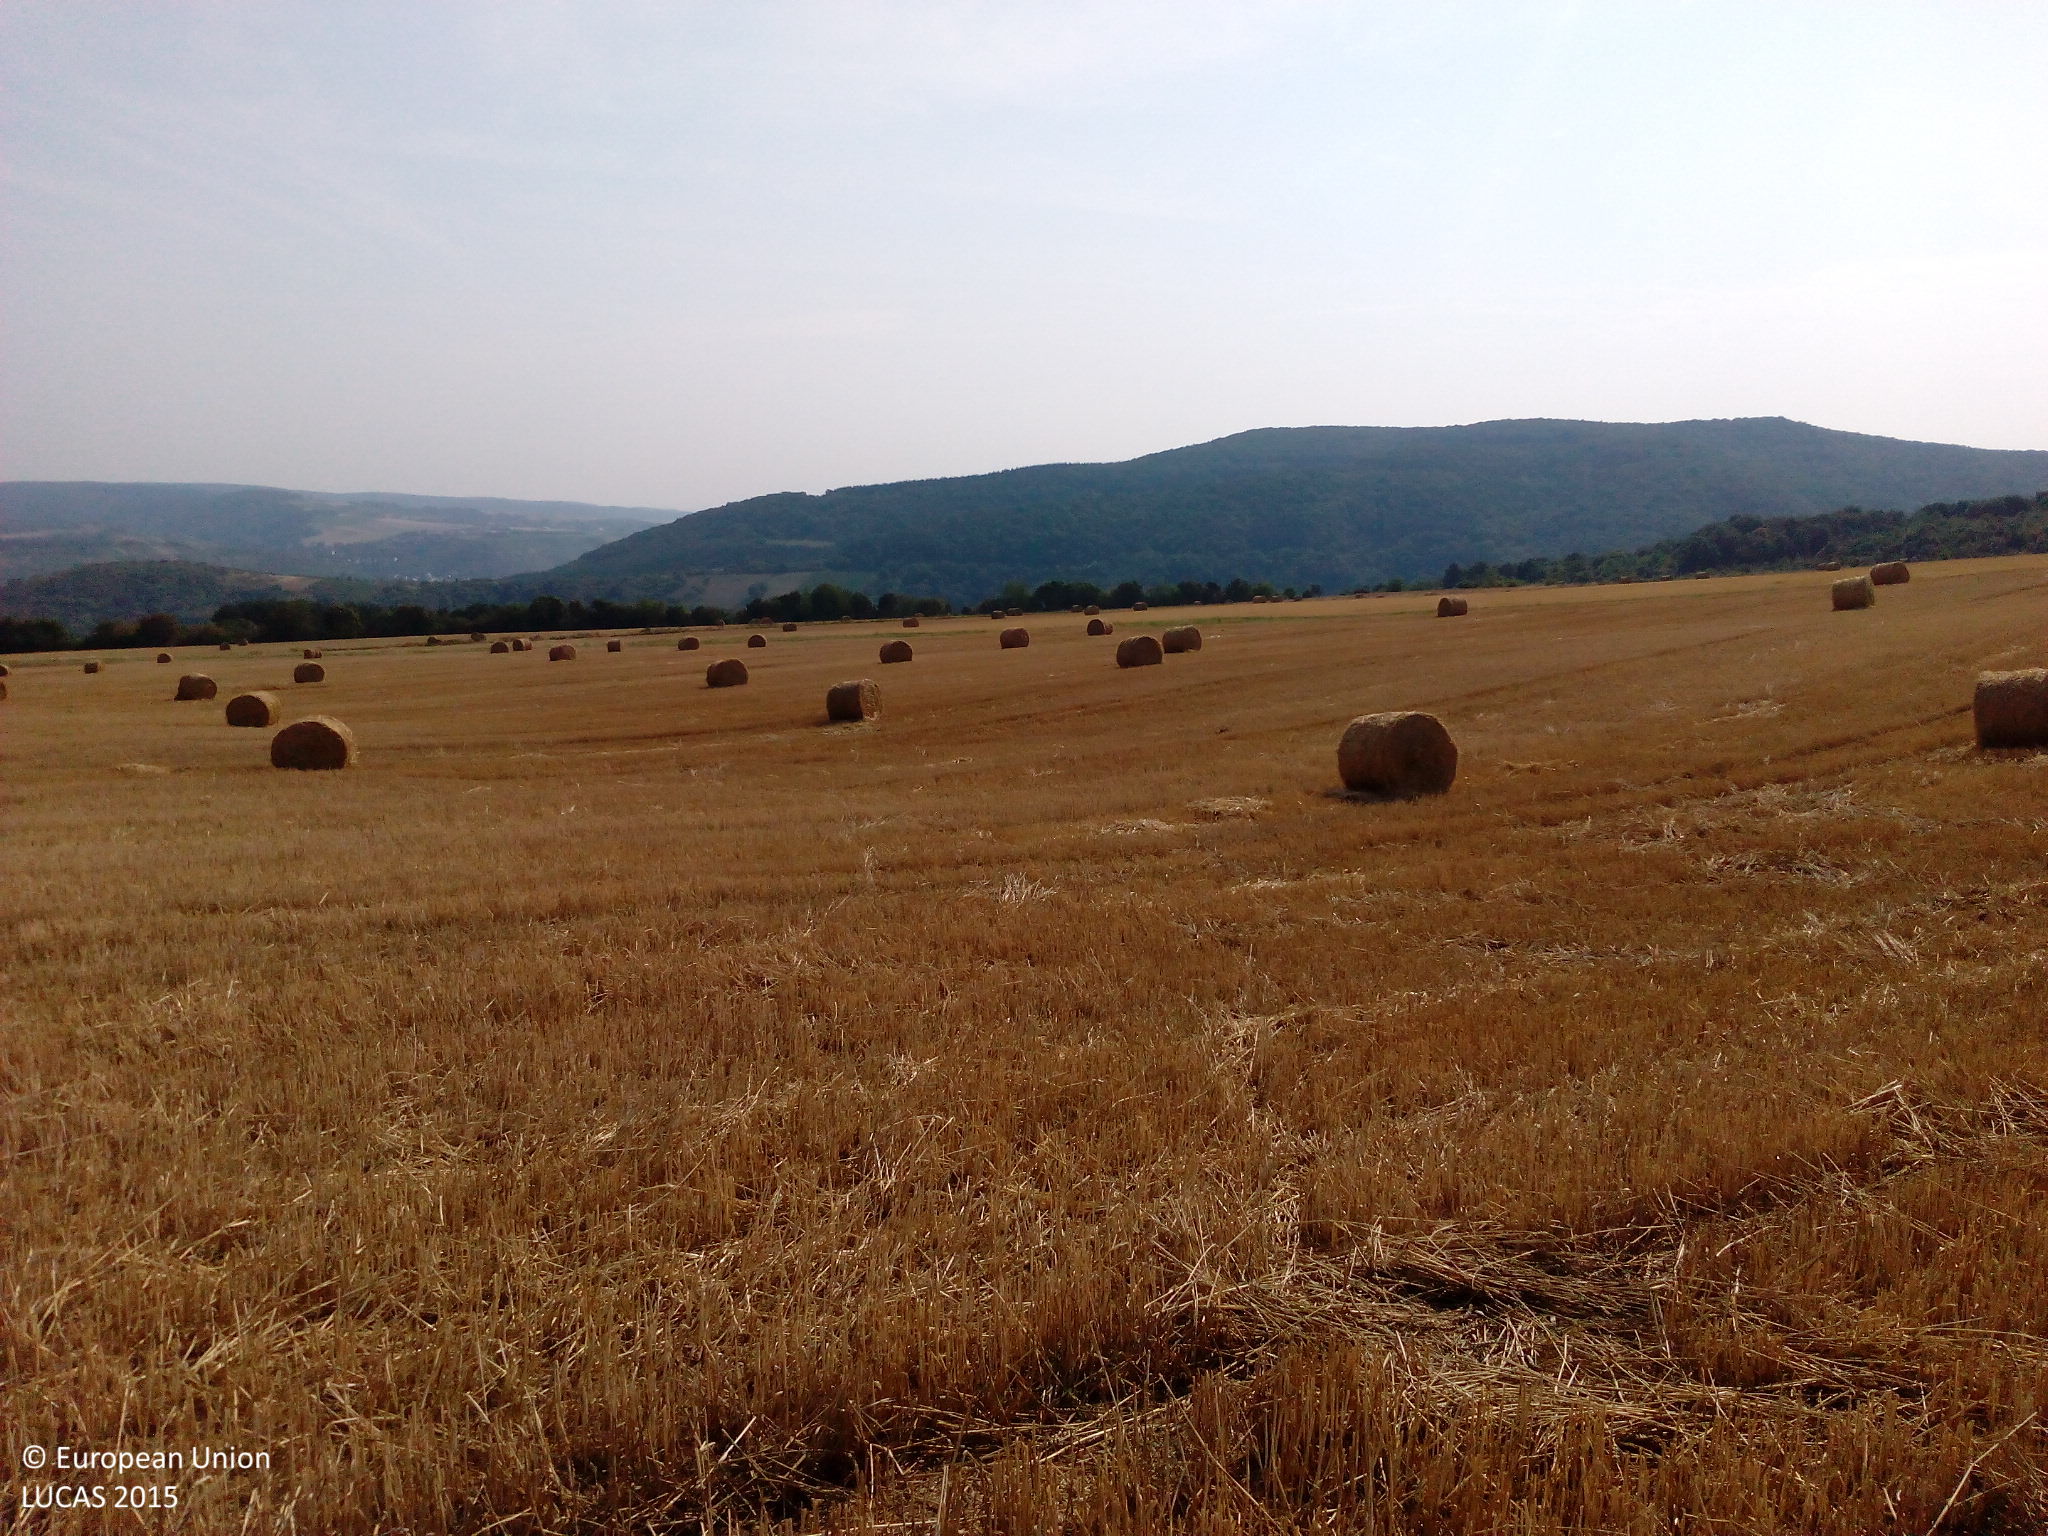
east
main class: Cropland
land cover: Common wheat
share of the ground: 10 - 25 %
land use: Agriculture (excluding fallow land and kitchen gardens)
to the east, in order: Common wheat; Grass margins; Paved roads, cycling and walking lanes; Grass margins; Ditches and canals; Grassland without tree/shrub cover; Common wheat
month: August
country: DE
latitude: 49.7799
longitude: 7.5423
